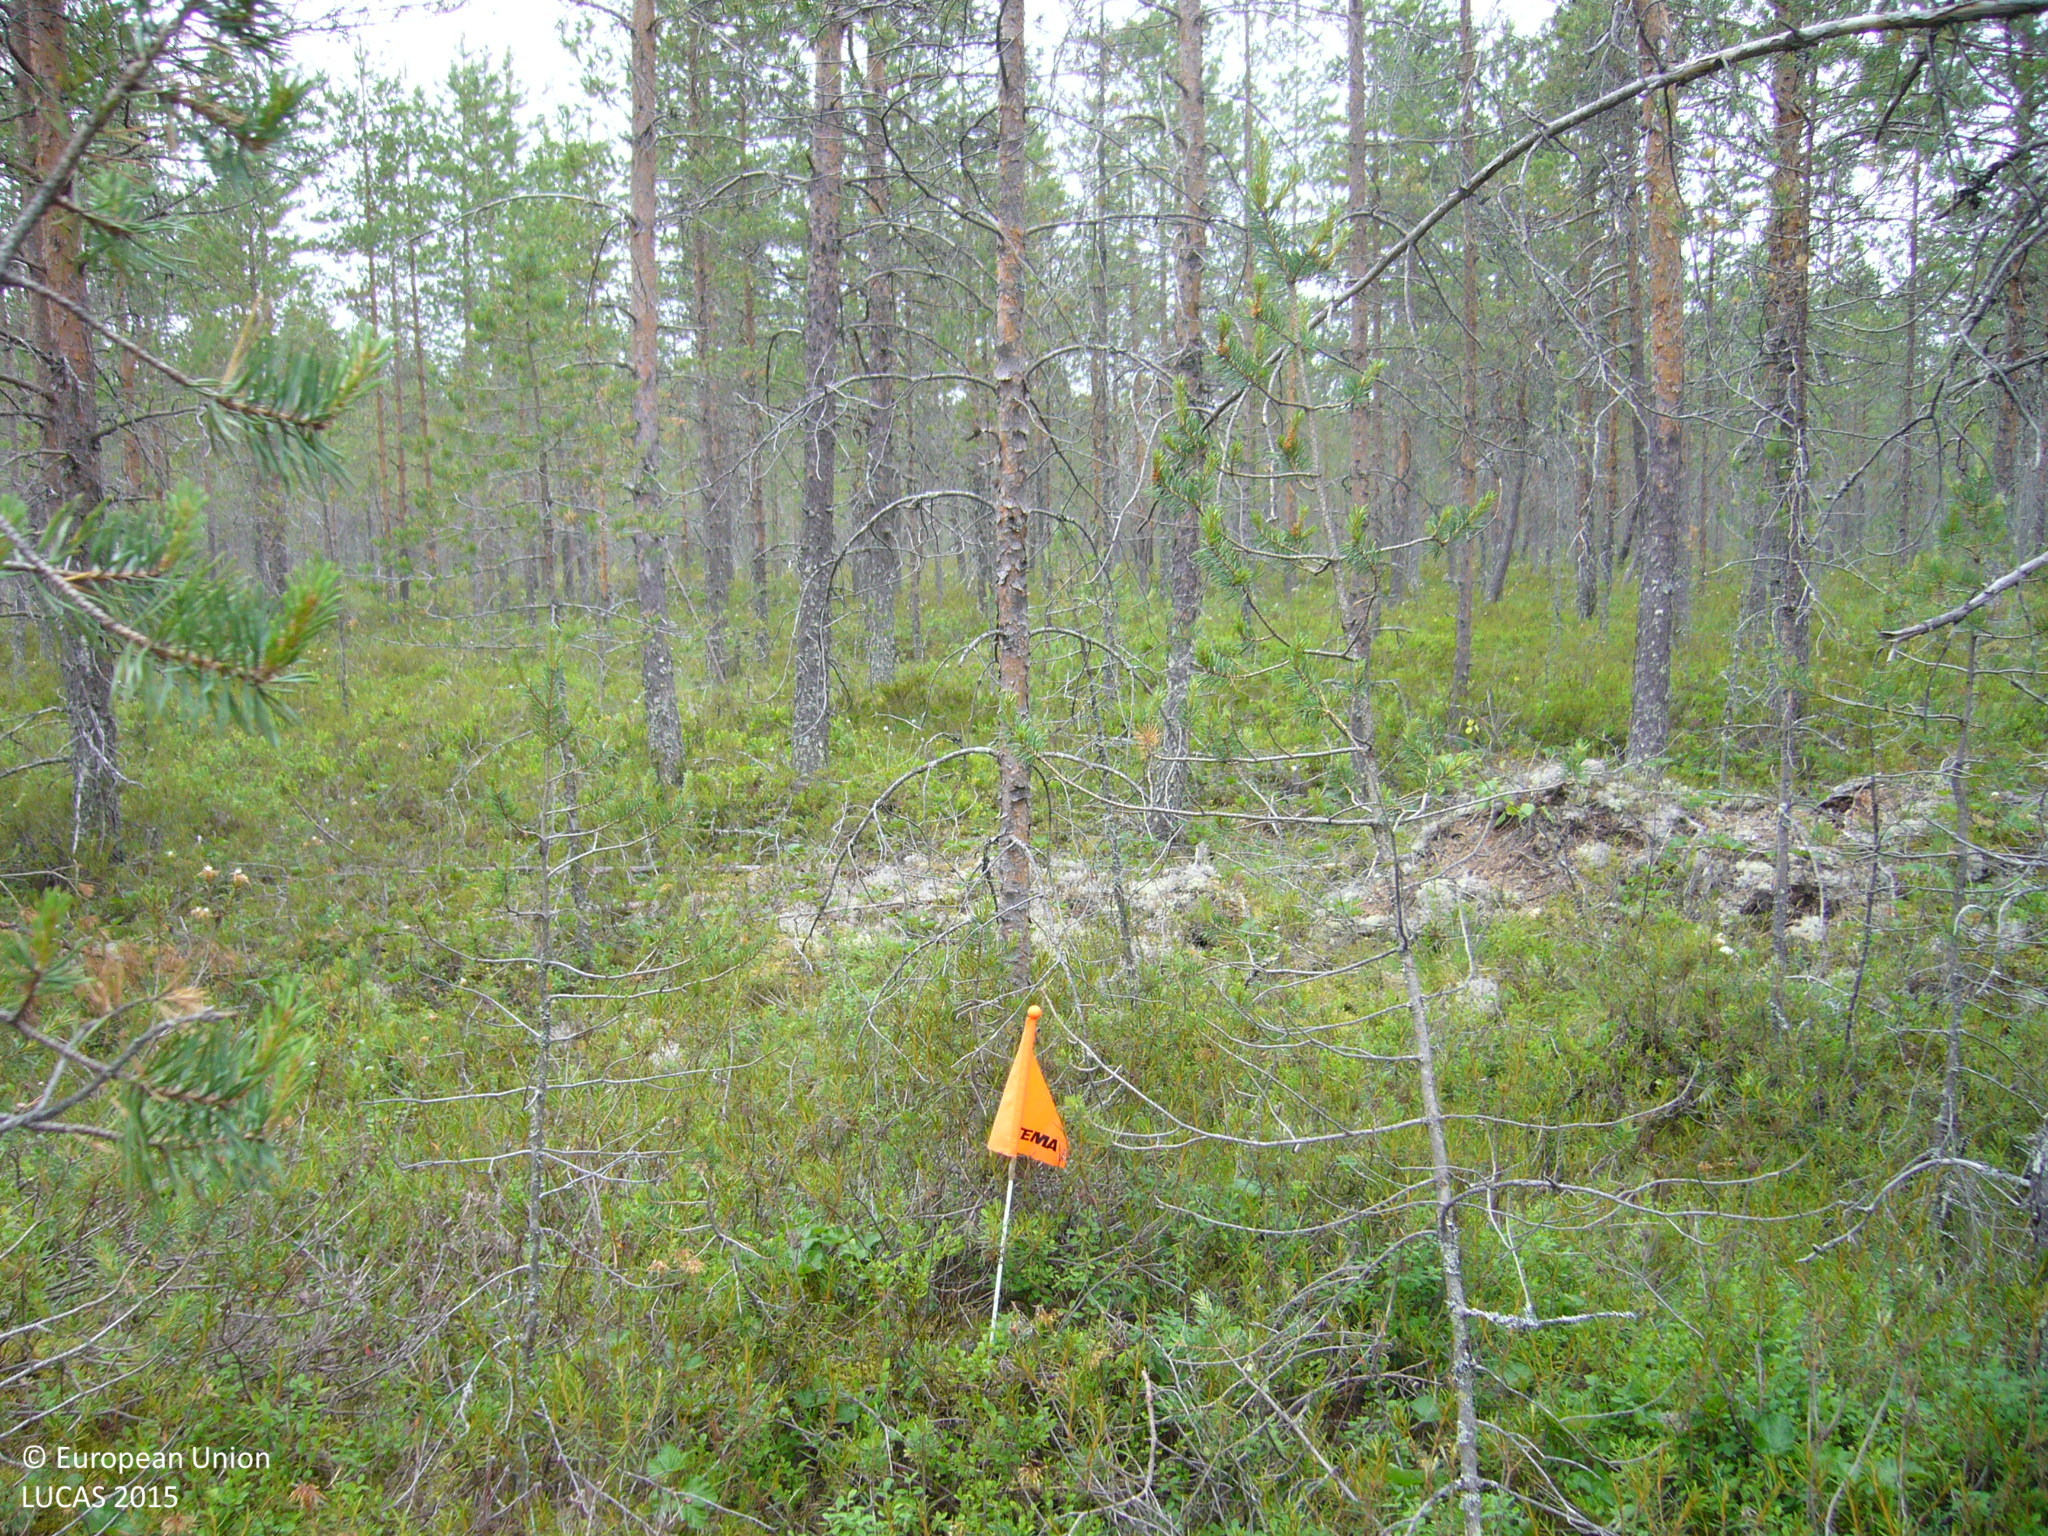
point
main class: Woodland
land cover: Pine dominated coniferous woodland
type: boreal forest
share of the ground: 50 - 75 %
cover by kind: coniferous forest trees 60 %, shrubs 40 %
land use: Forestry
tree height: > 5 m
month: July
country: FI
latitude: 63.4635
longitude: 25.8593
